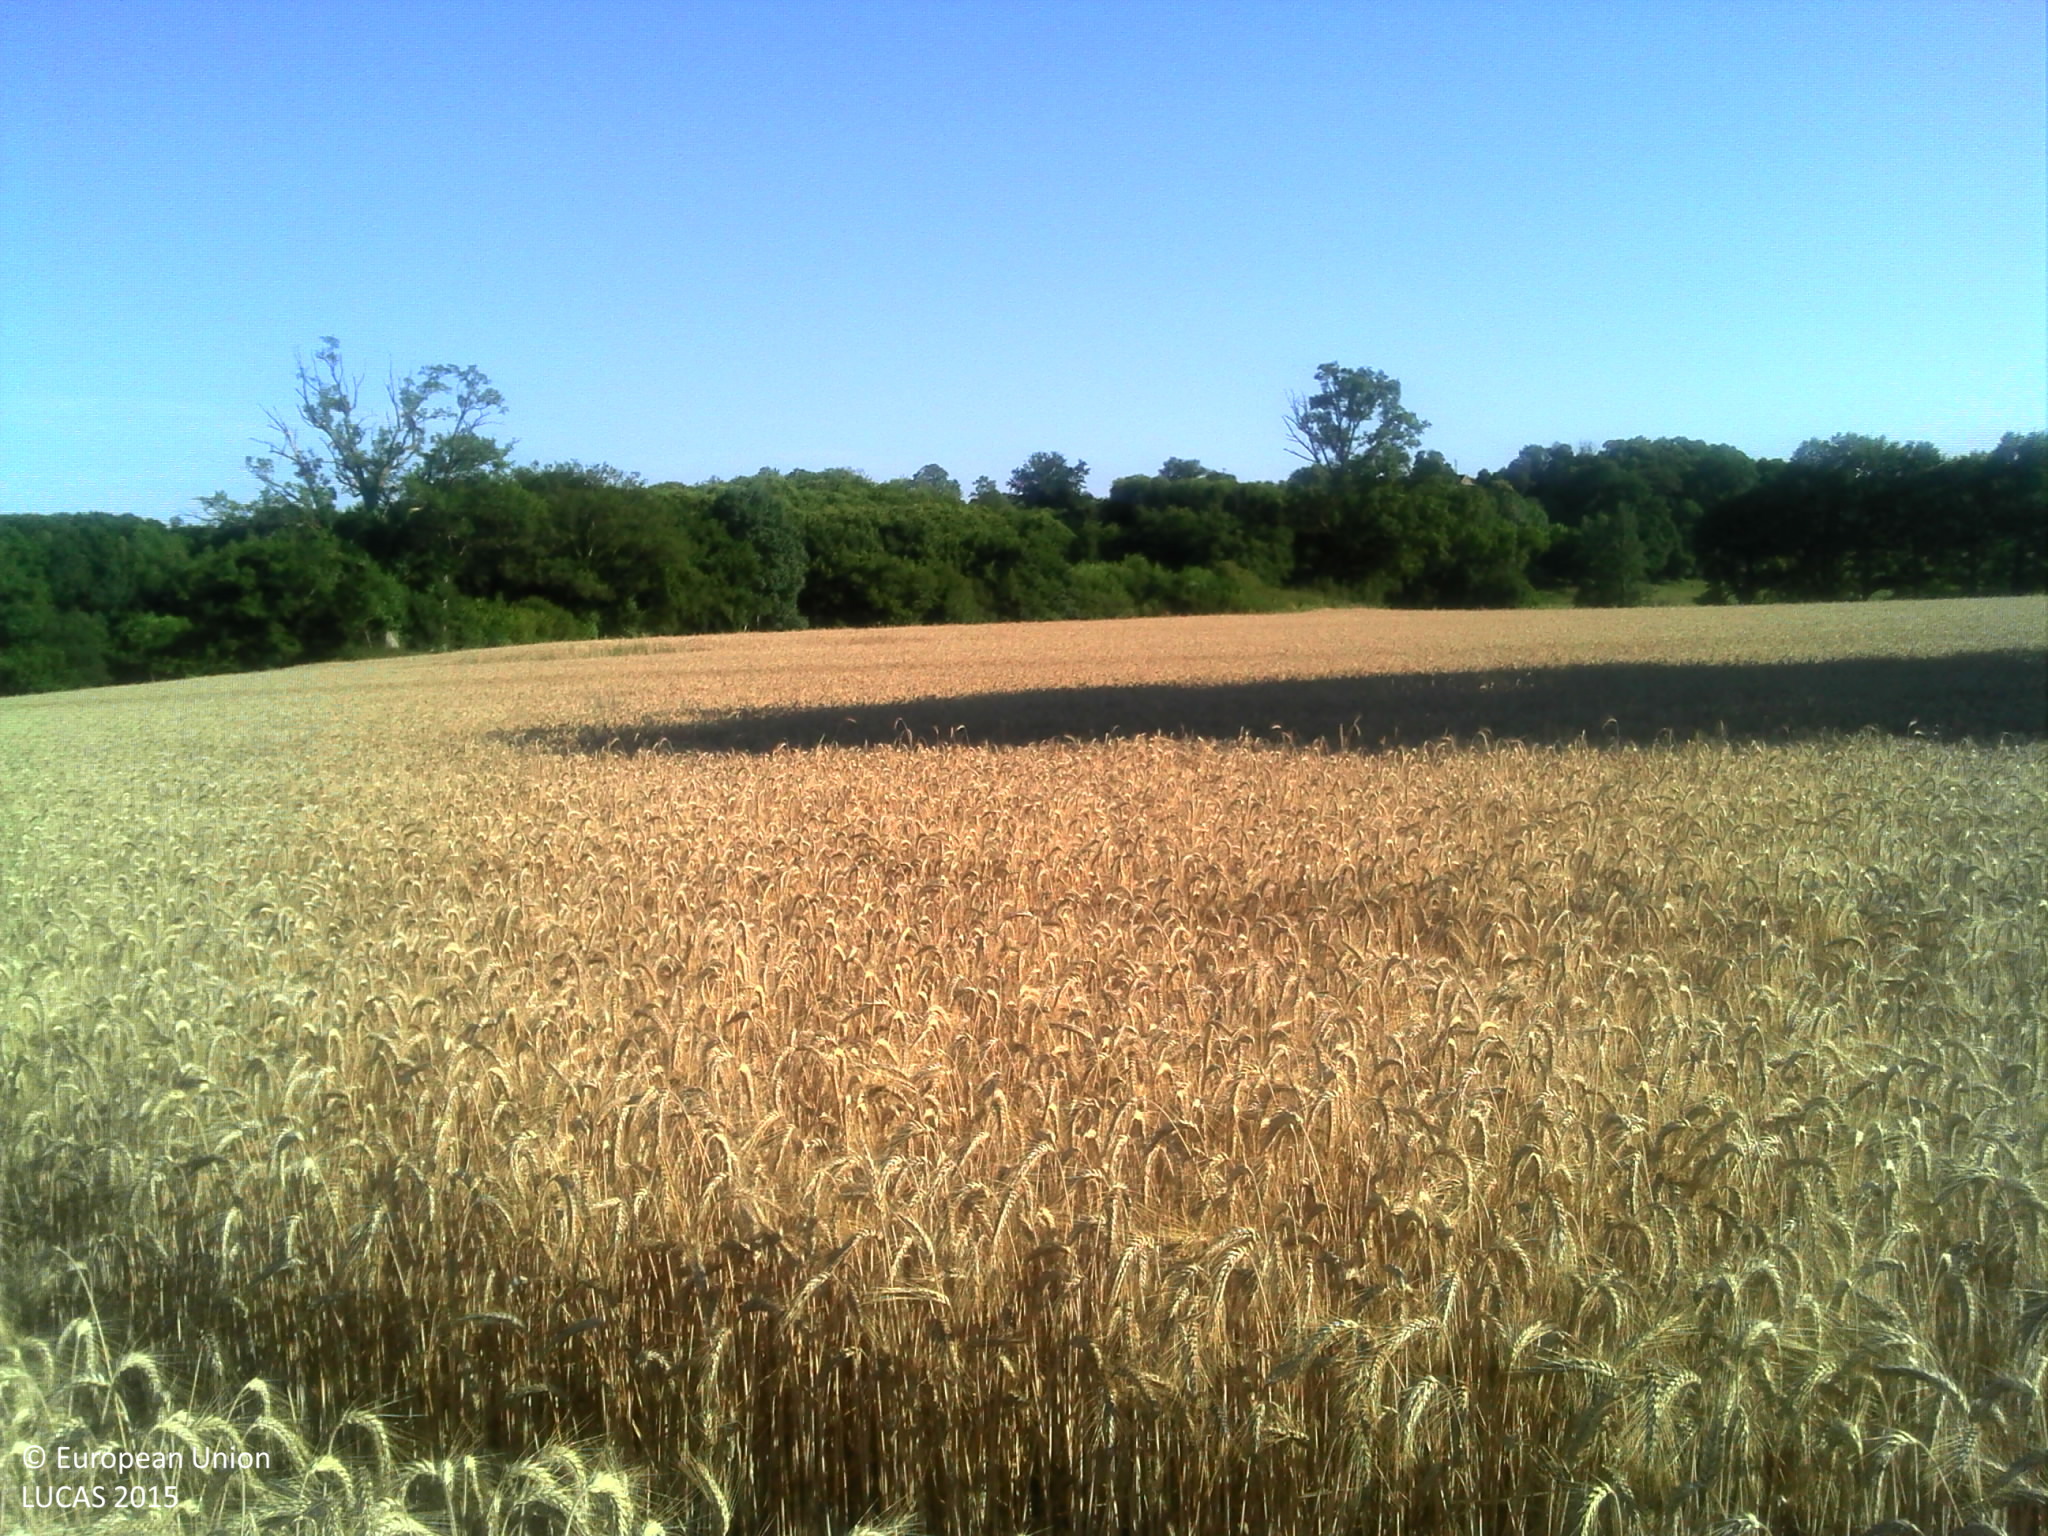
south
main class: Cropland
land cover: Common wheat
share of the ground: > 75 %
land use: Agriculture (excluding fallow land and kitchen gardens)
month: July
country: FR
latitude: 46.2357
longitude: 1.5752
